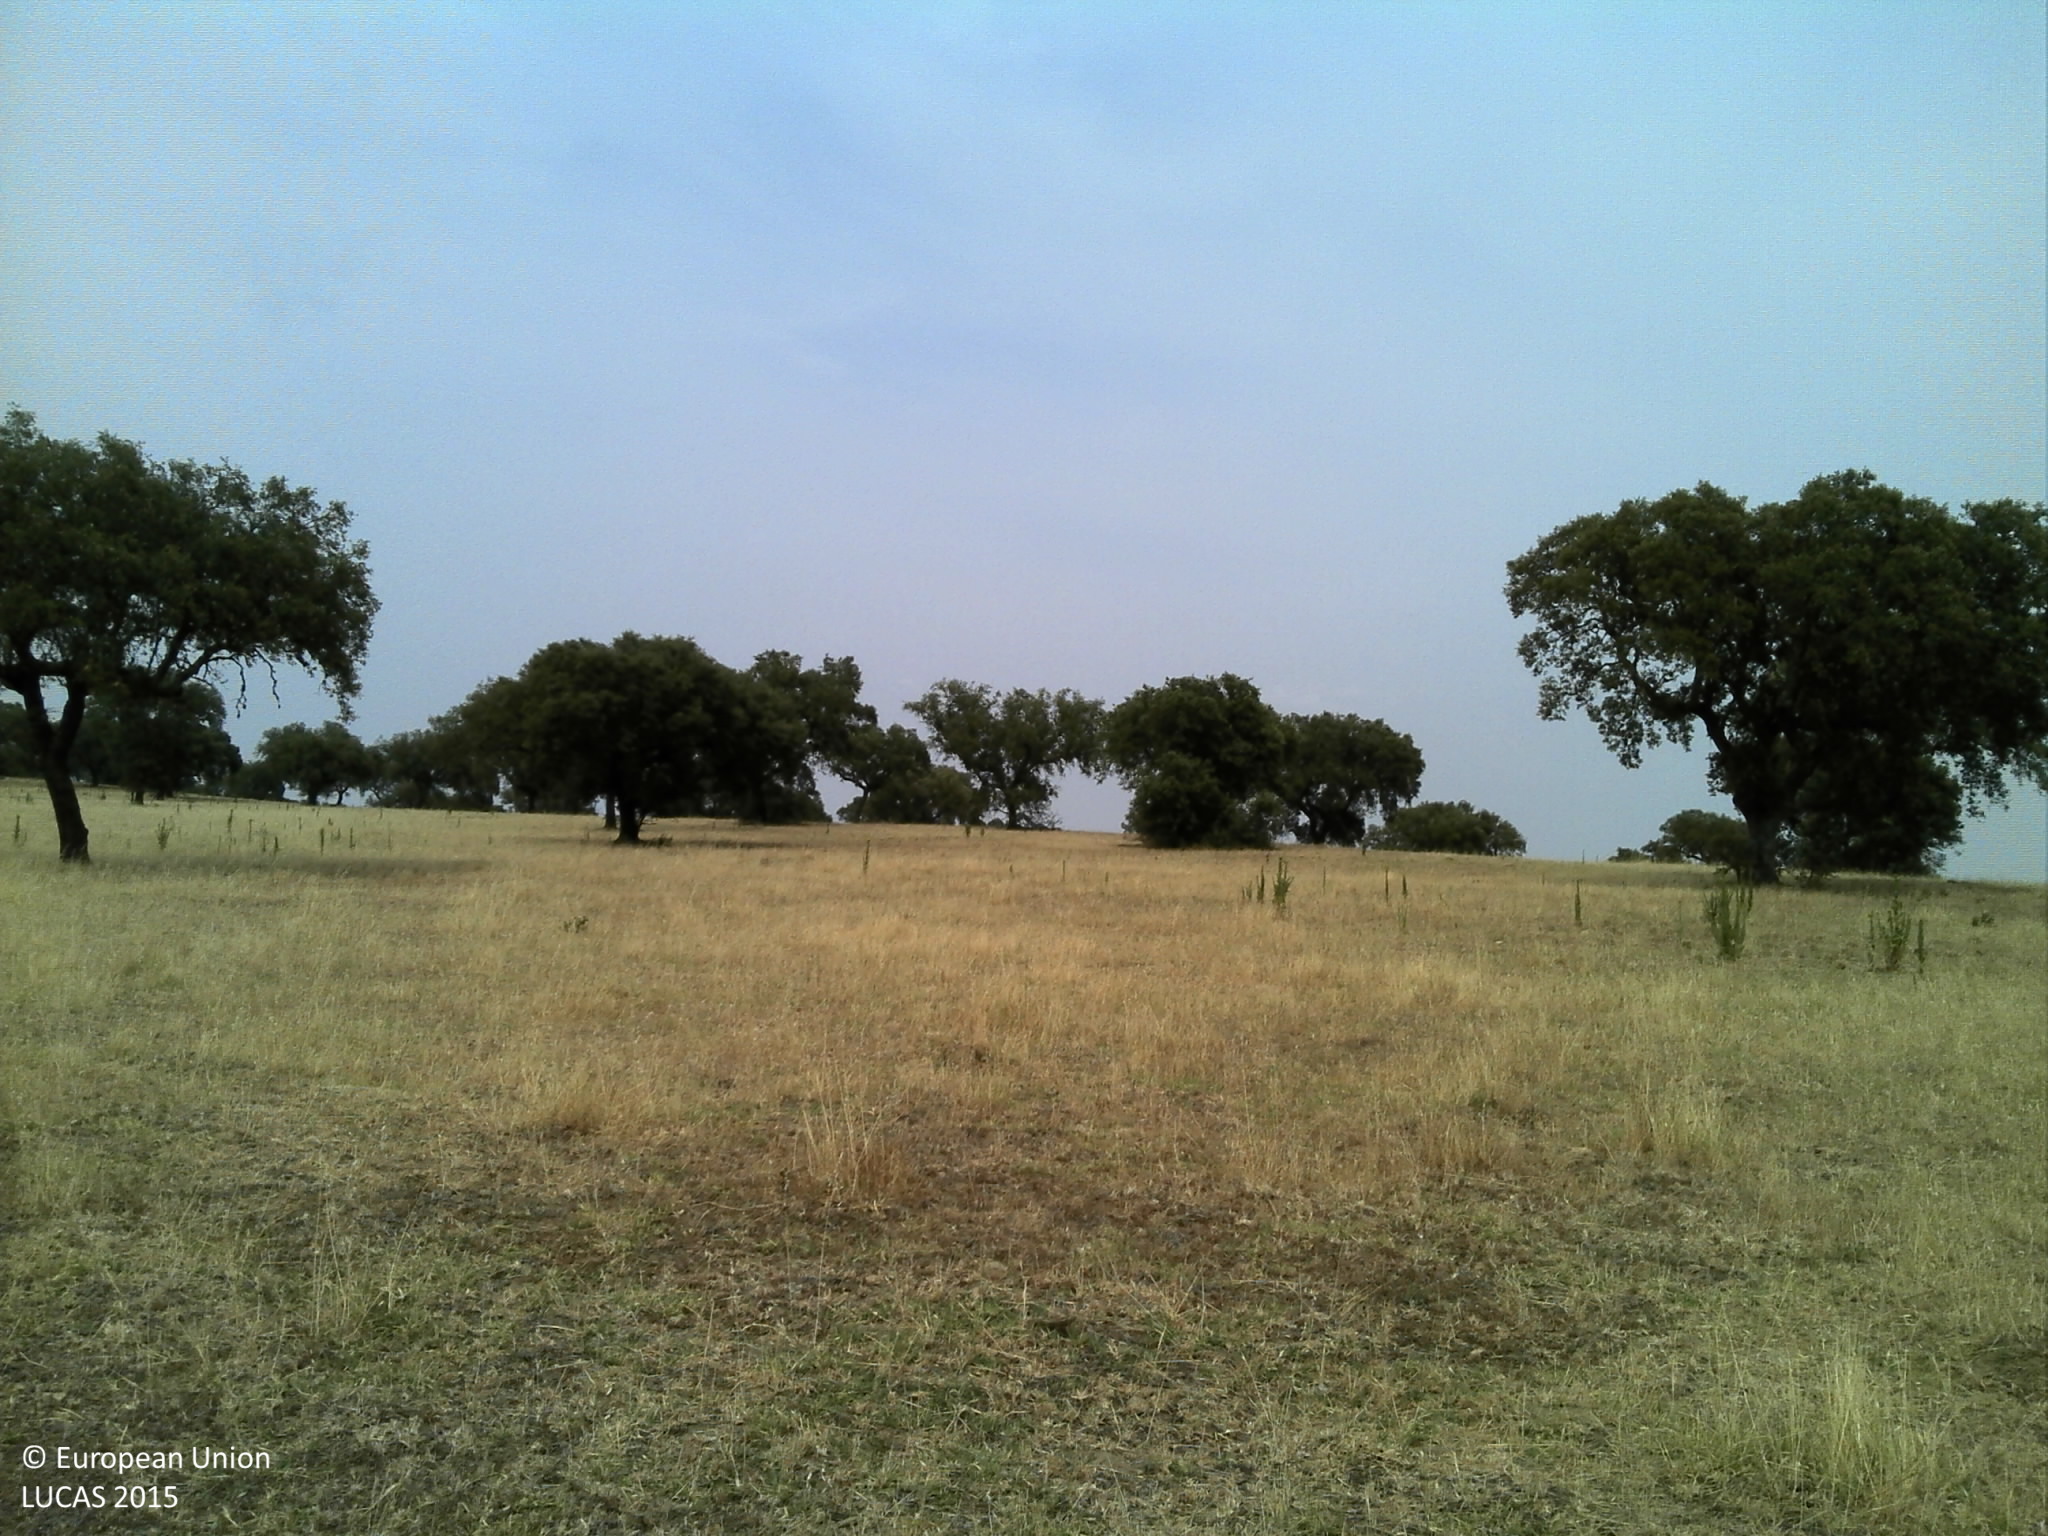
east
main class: Grassland
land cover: Grassland without tree/shrub cover
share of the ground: 25 - 50 %
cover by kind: unconsolidated bare surface 65 %, herbaceous plants 35 %
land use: Agriculture (excluding fallow land and kitchen gardens)
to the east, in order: Grassland without tree/shrub cover; Broadleaved woodland; Grassland without tree/shrub cover; Single bushes/trees; Grassland without tree/shrub cover; Single bushes/trees; Other bare soil; Tracks; Other bare soil; Fences; Grass margins; Ditches and canals; Tracks; Grass margins; Fences; Grassland without tree/shrub cover
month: June
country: PT
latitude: 38.4216
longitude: -7.7991
